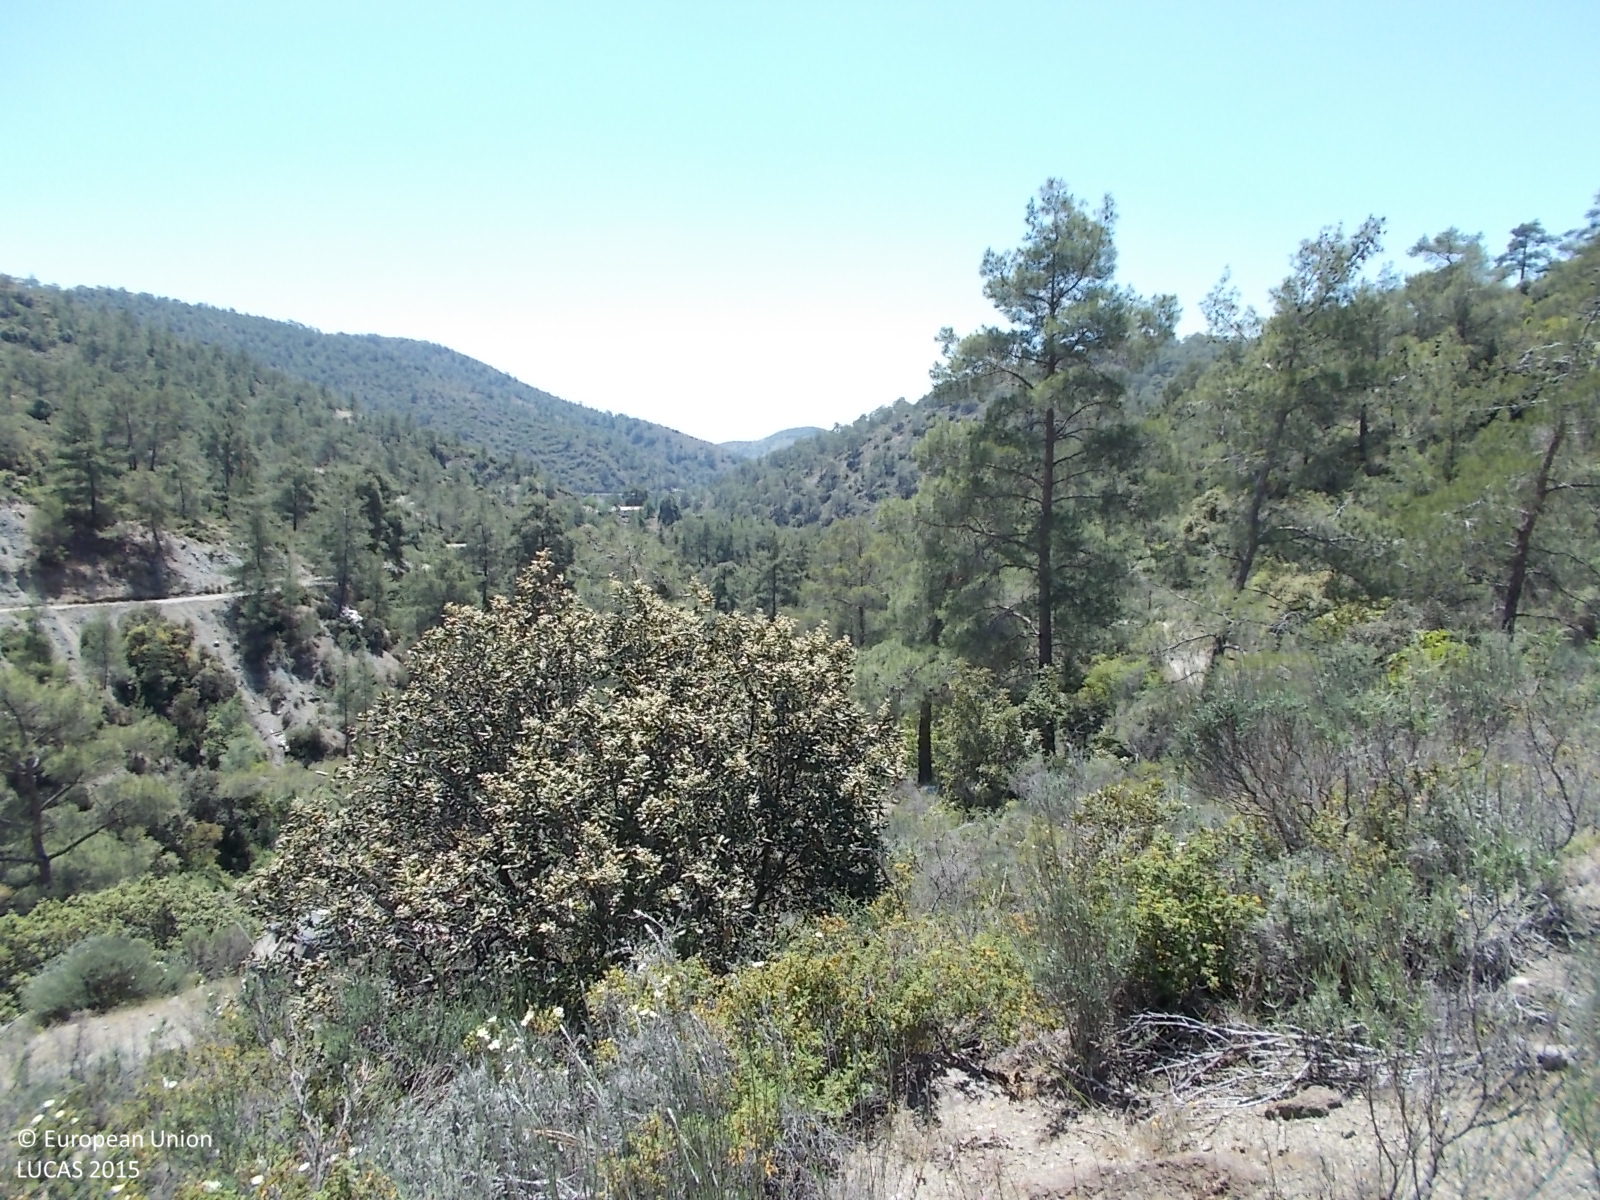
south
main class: Shrubland
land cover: Shrubland with sparse tree cover
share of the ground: > 75 %
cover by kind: shrubs 75 %, unconsolidated bare surface 20 %, broadleaved forest trees 5 %
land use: Semi-natural and natural areas not in use
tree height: < 5 m
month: May
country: CY
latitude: 34.8236
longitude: 33.0308
